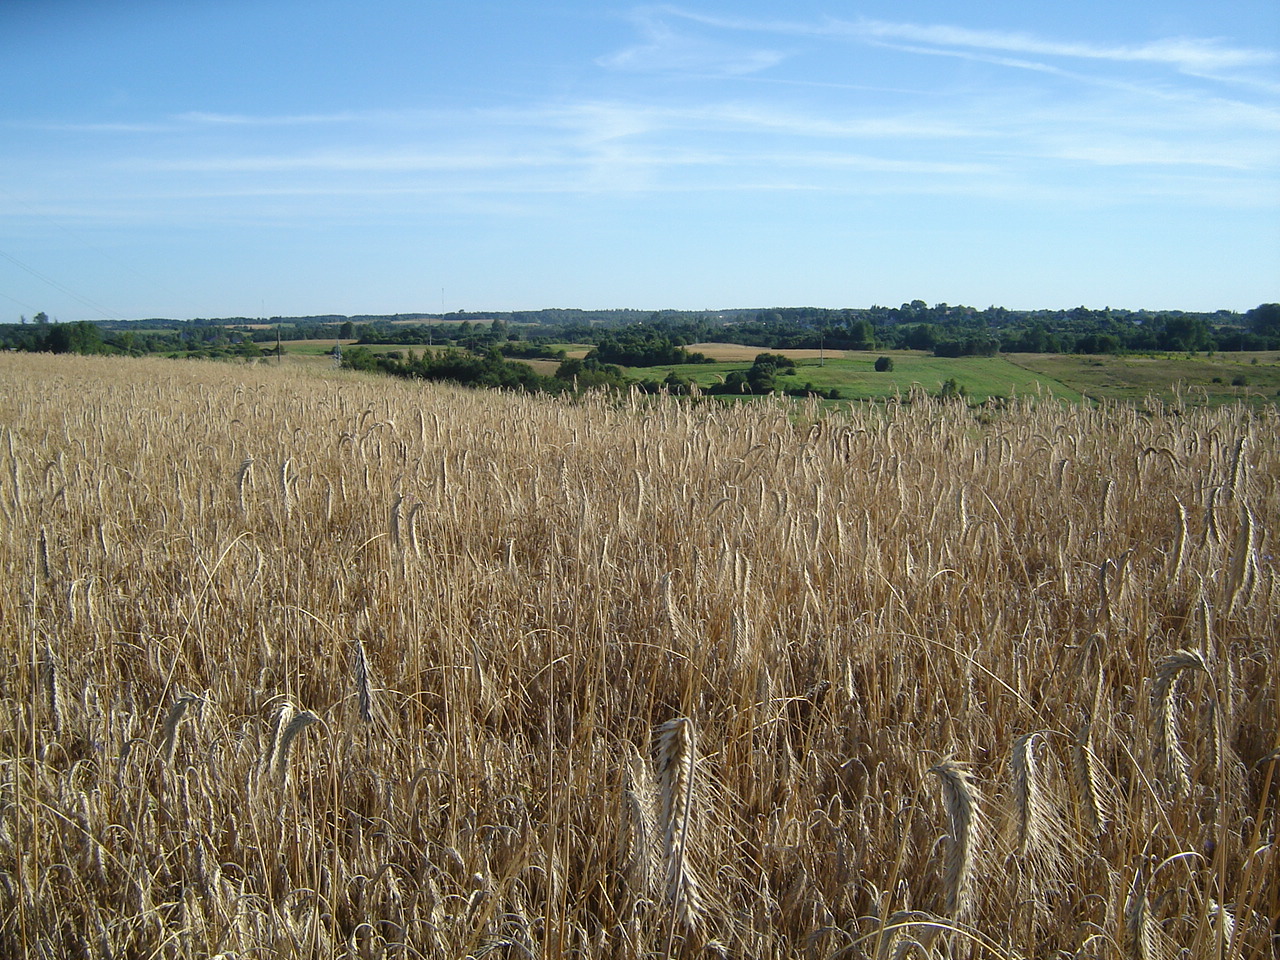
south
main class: Cropland
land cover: Durum wheat
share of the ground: > 75 %
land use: Agriculture (excluding fallow land and kitchen gardens)
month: August
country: LT
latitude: 54.9564
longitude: 25.2518
